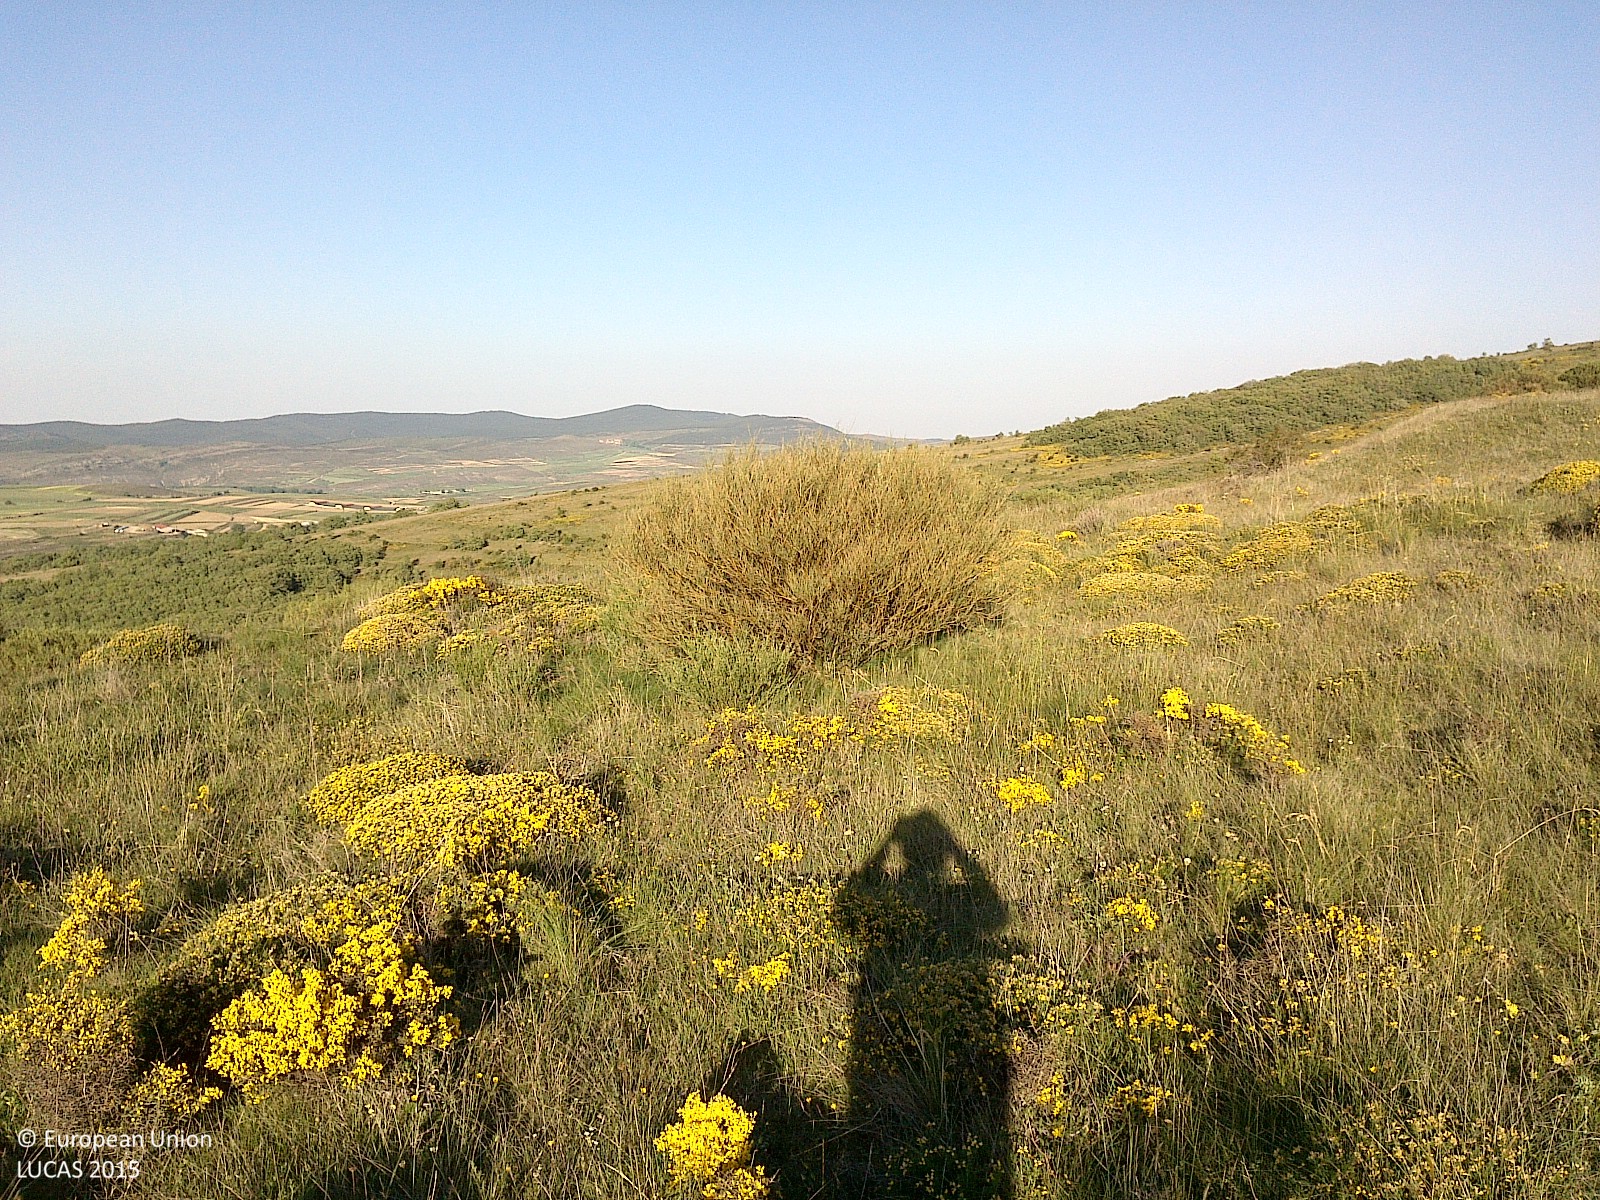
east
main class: Shrubland
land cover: Shrubland without tree cover
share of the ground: 50 - 75 %
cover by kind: shrubs 55 %, herbaceous plants 45 %
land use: Agriculture (excluding fallow land and kitchen gardens)
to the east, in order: Shrubland without tree cover; Grassland without tree/shrub cover; Shrubland without tree cover; Grassland without tree/shrub cover; Shrubland without tree cover; Rock outcrops; Tracks; Shrubland without tree cover
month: May
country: ES
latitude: 42.0114
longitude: -2.2946
